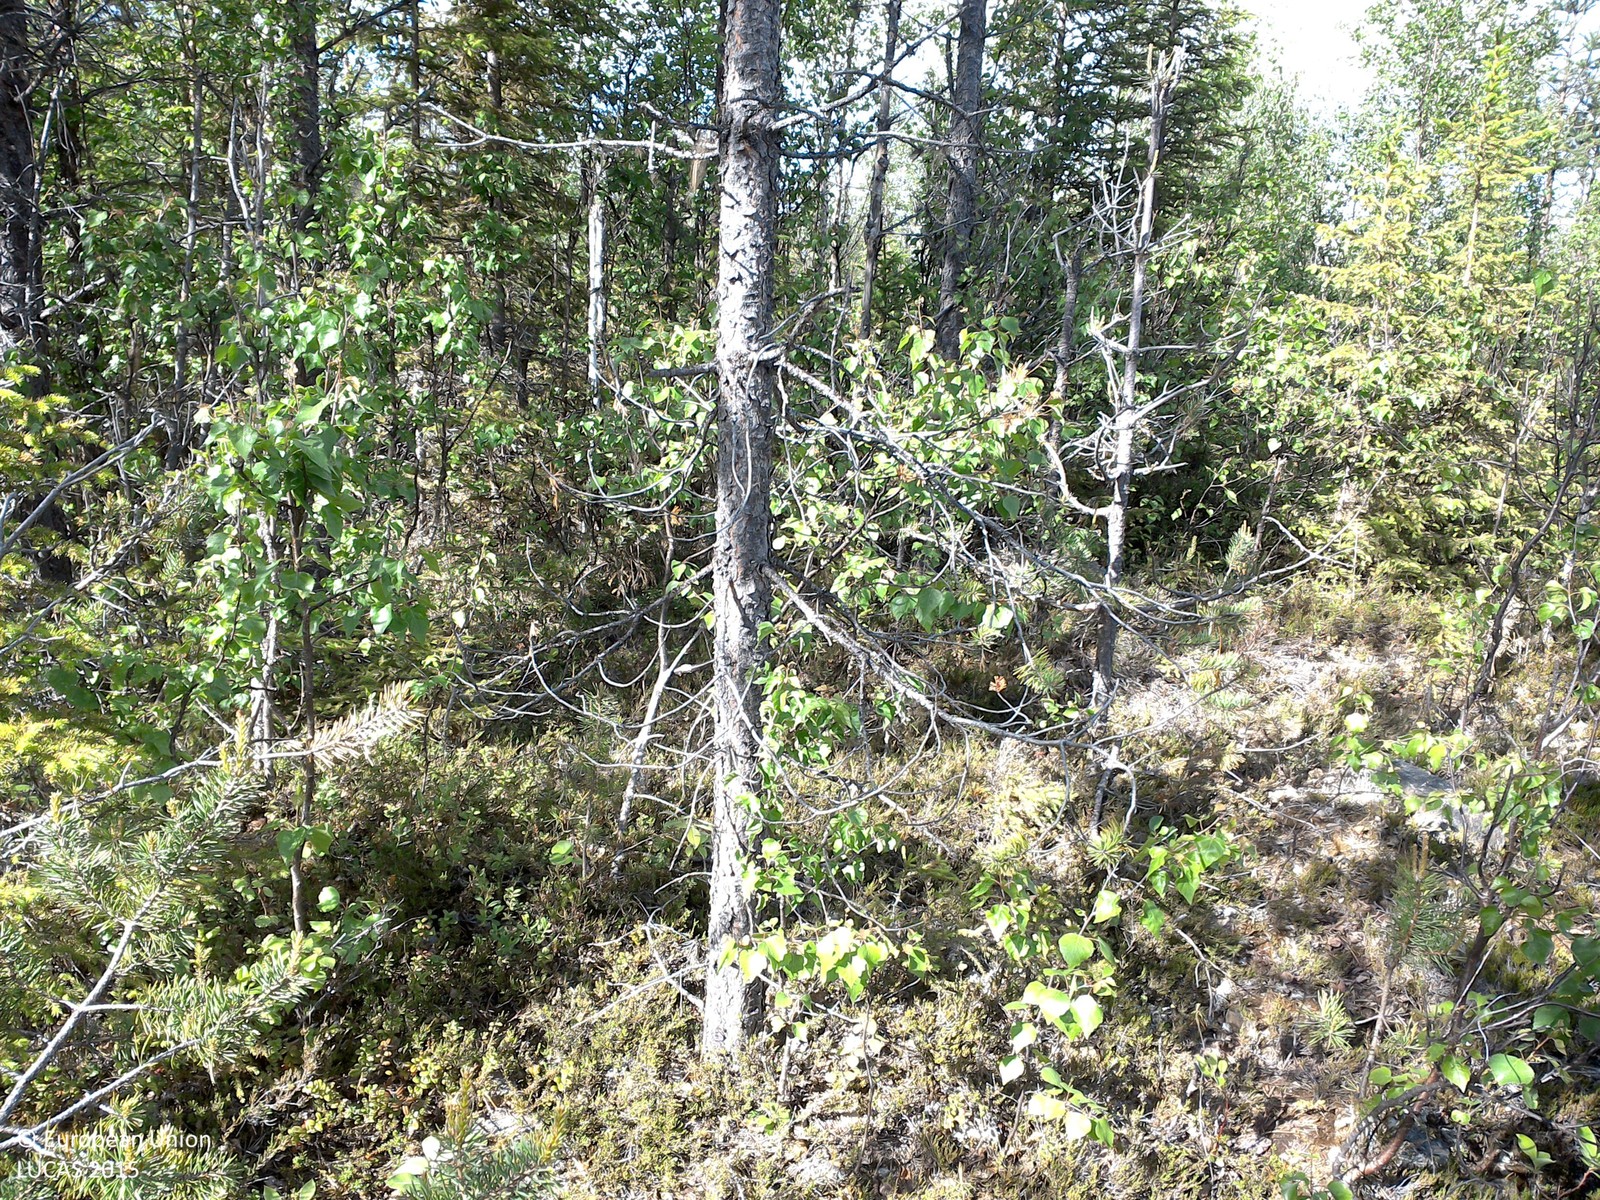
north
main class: Woodland
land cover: Pine dominated mixed woodland
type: boreal forest
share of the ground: 25 - 50 %
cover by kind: shrubs 65 %, coniferous forest trees 15 %, broadleaved forest trees 10 %, lichens and mosses 5 %, unconsolidated bare surface 5 %
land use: Forestry
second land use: Amenities, museums, leisure
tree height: > 5 m
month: June
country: SE
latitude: 66.6308
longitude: 22.8287
